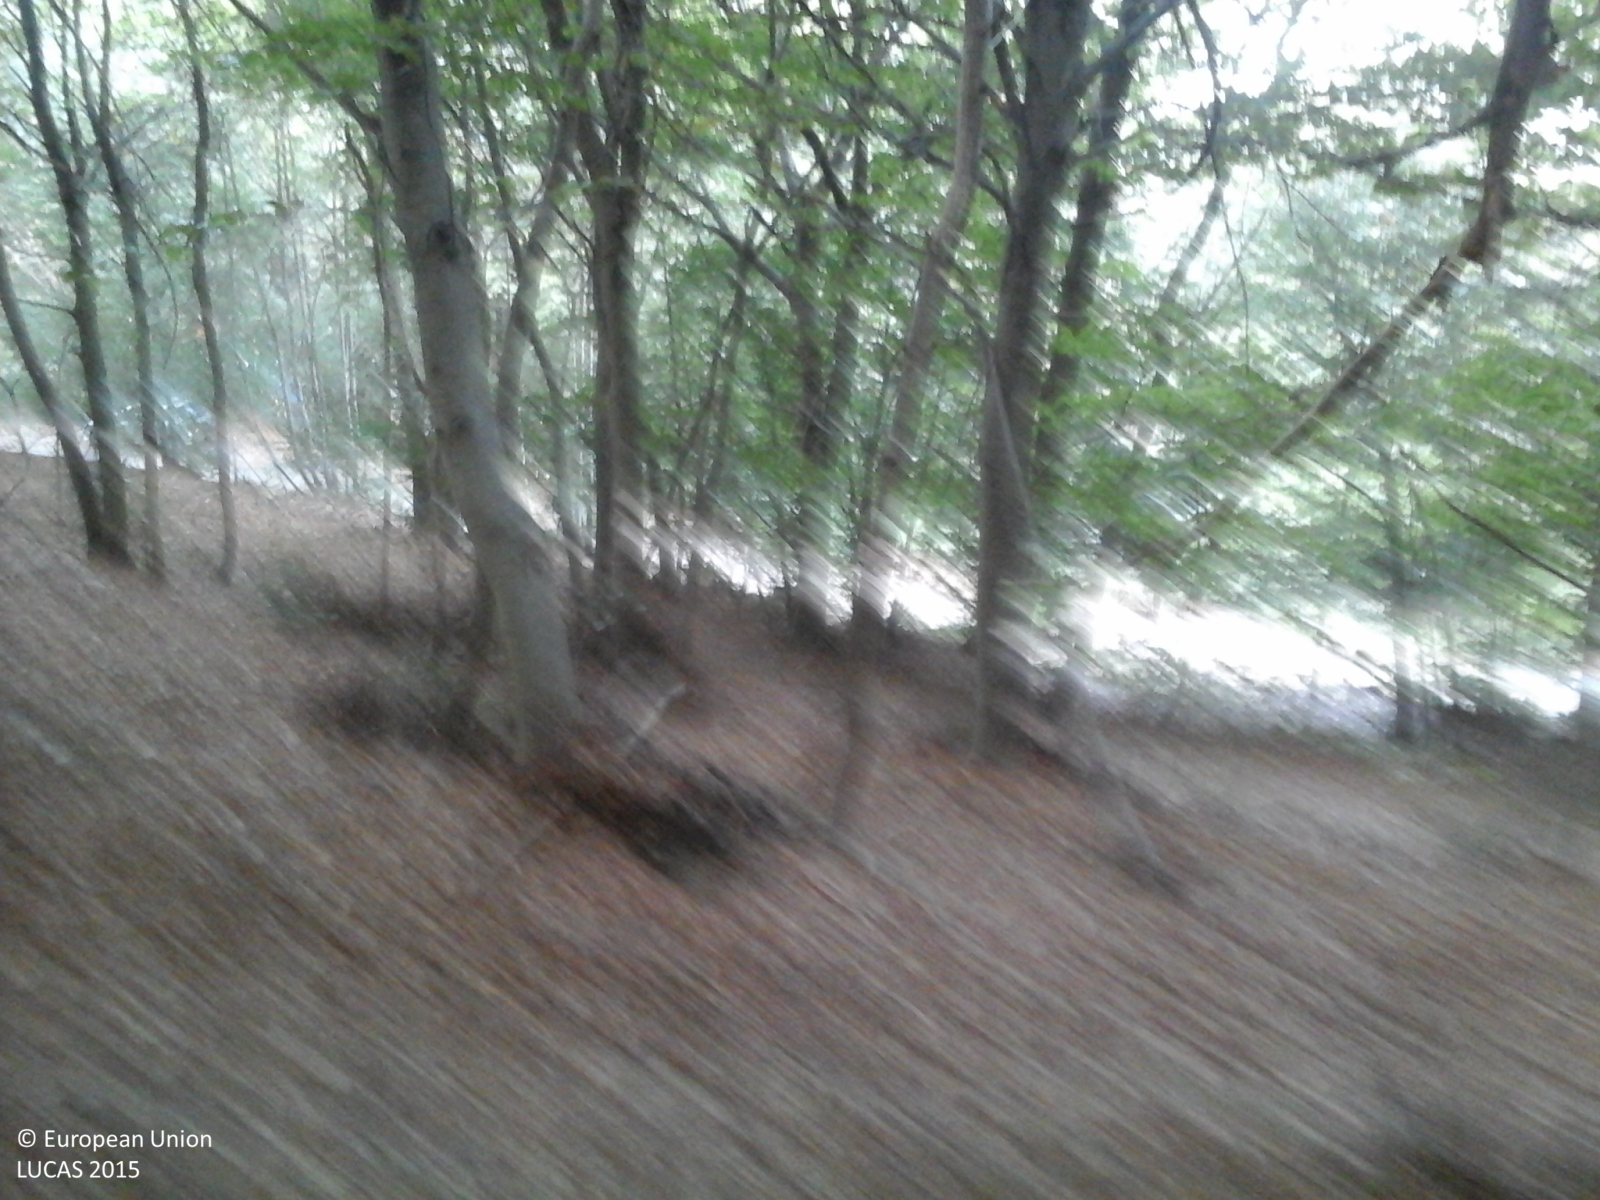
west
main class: Woodland
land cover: Broadleaved woodland
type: thermophilous deciduous forest
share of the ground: > 75 %
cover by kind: broadleaved forest trees 100 %
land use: Forestry
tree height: > 5 m
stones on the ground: 25 - 50 %
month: September
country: IT
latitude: 44.3192
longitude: 8.3362
